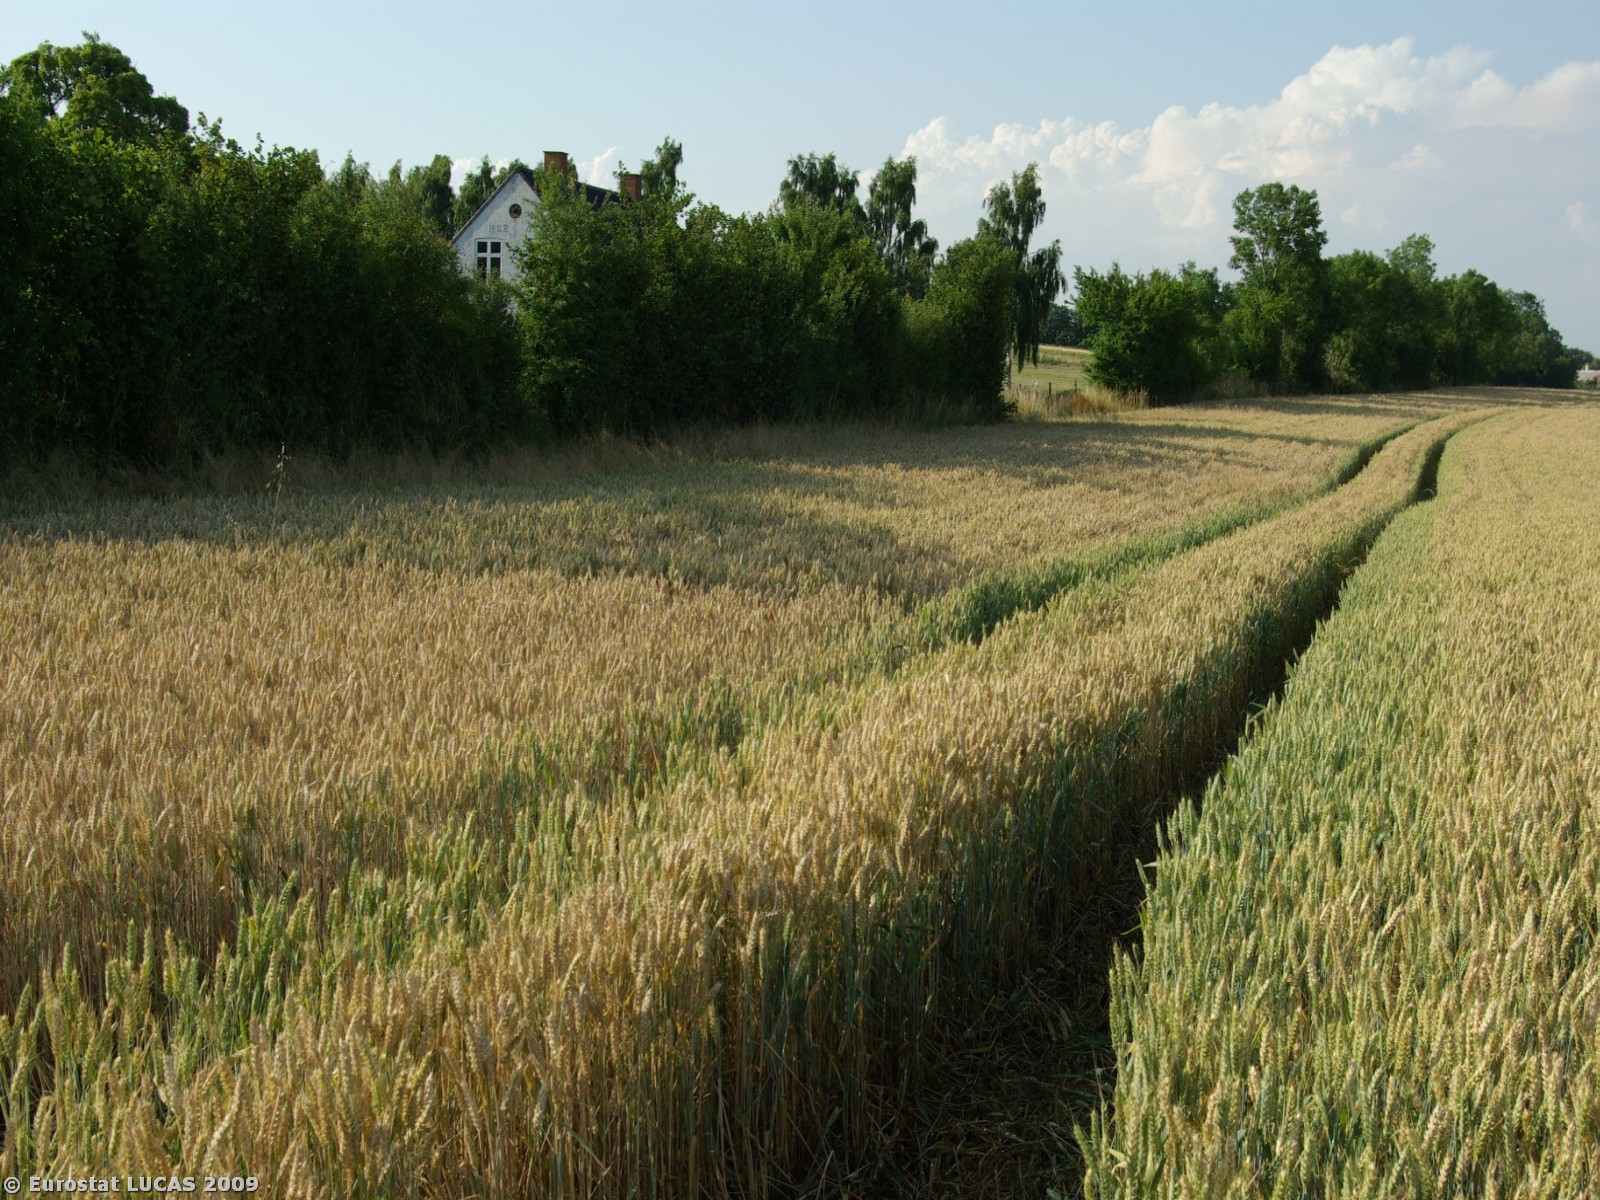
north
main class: Cropland
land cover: Common wheat
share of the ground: > 75 %
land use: Agriculture (excluding fallow land and kitchen gardens)
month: July
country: DK
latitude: 55.0191
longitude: 9.7343
